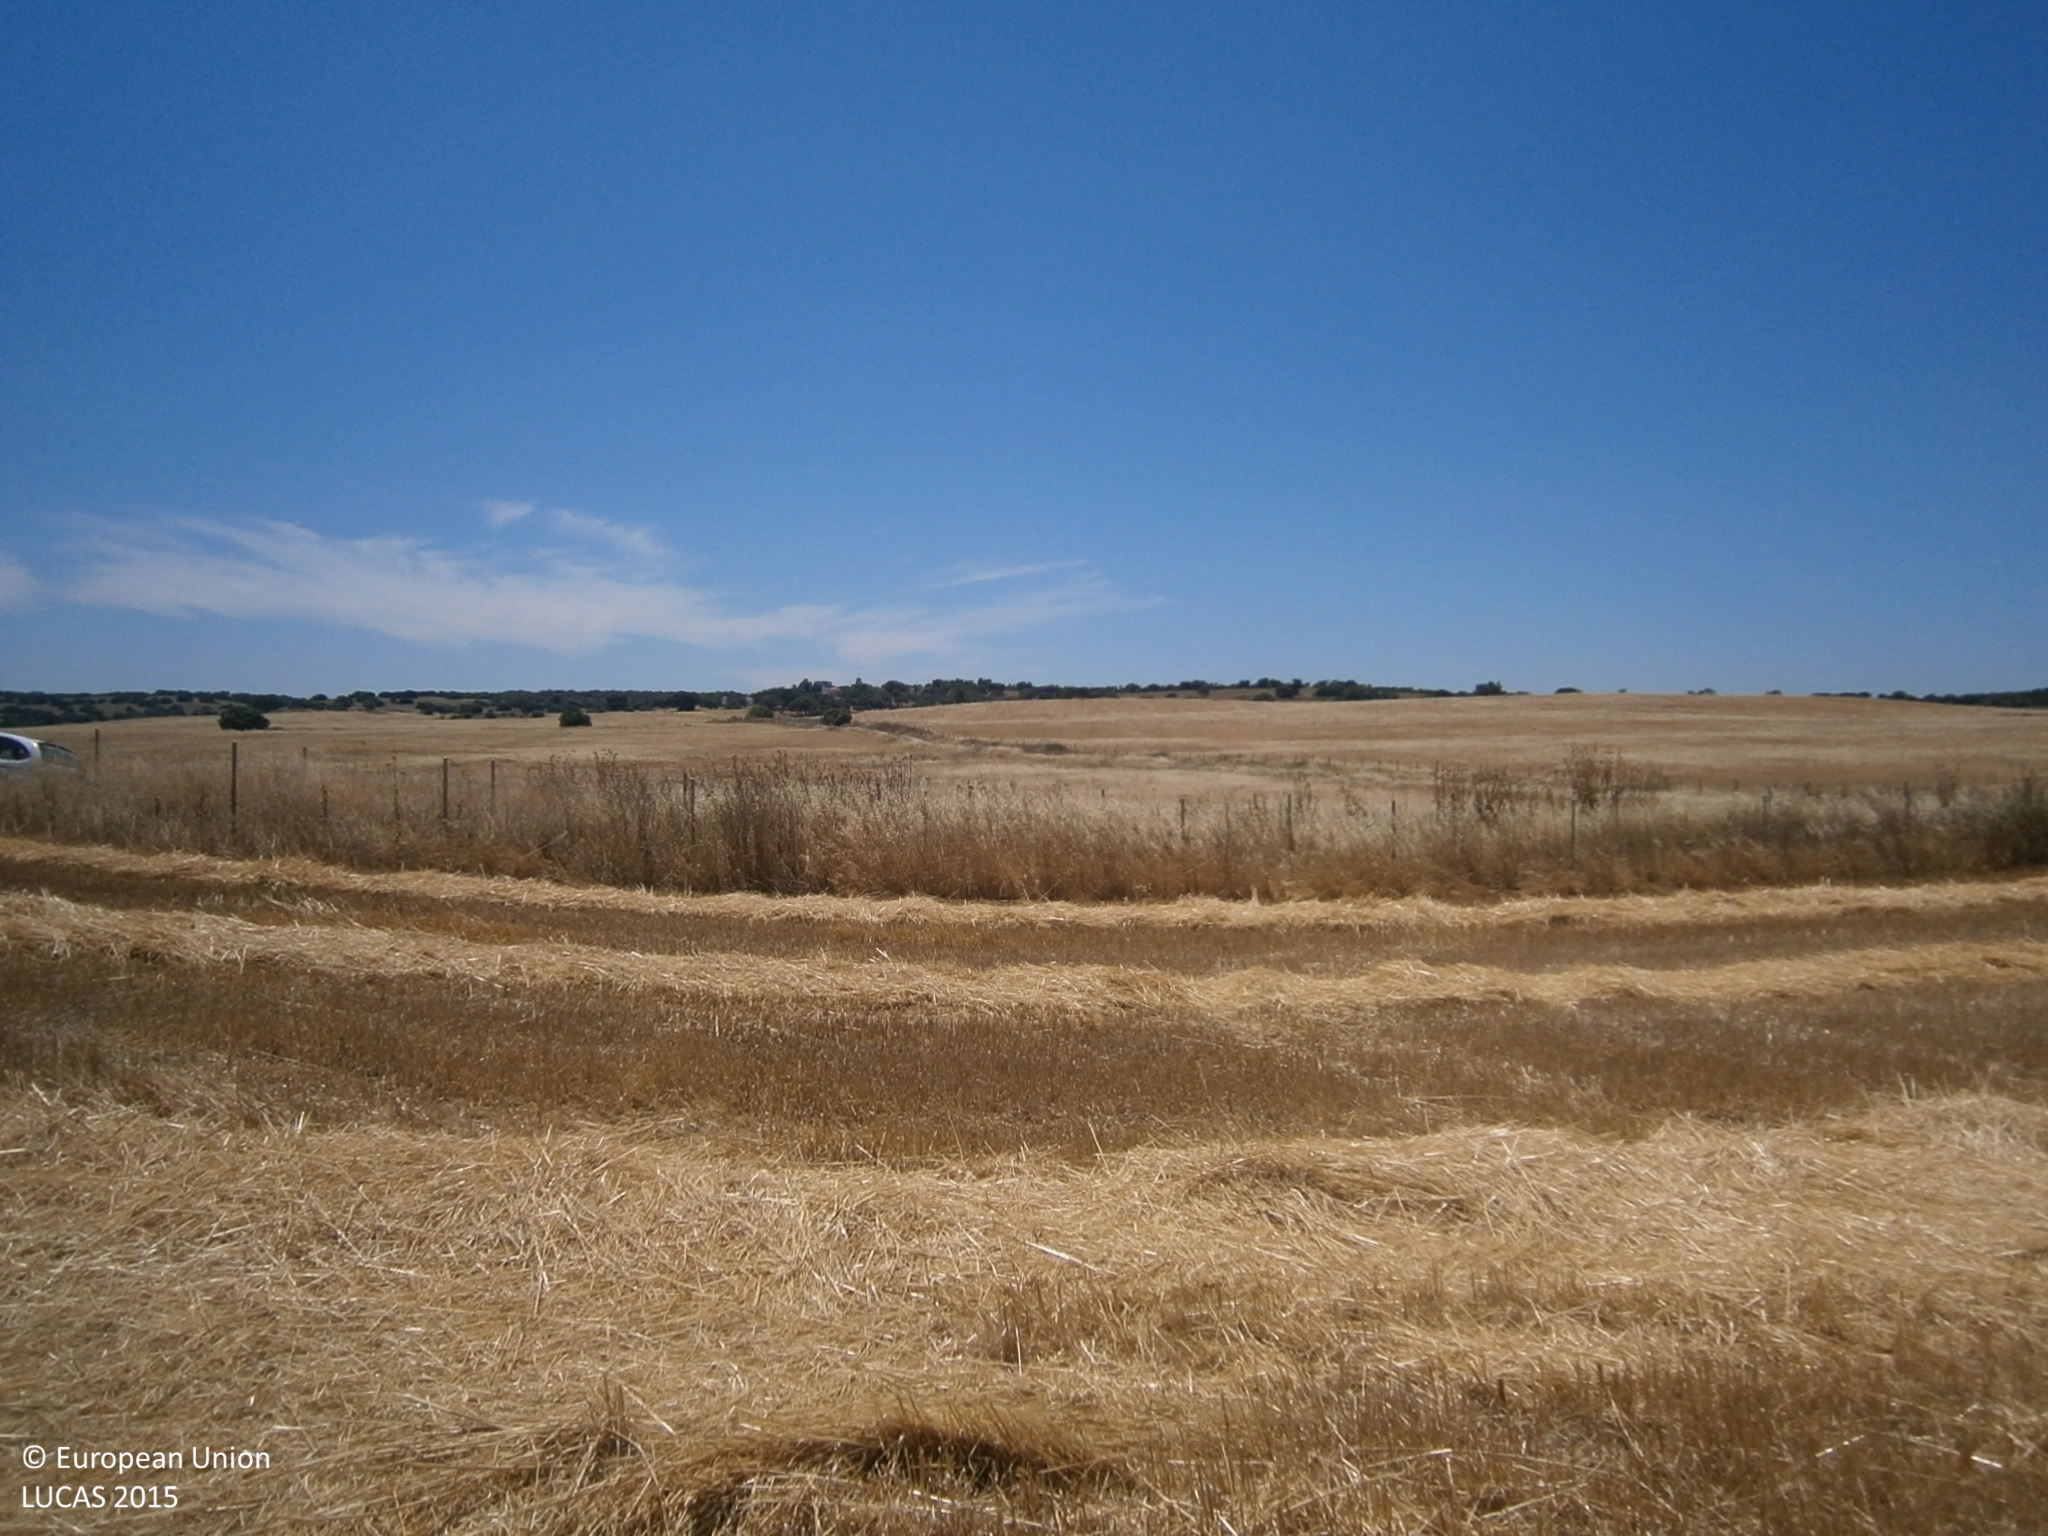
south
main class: Cropland
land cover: Oats
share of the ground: > 75 %
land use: Agriculture (excluding fallow land and kitchen gardens)
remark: Harvested field
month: June
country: ES
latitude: 38.6561
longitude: -6.9224
